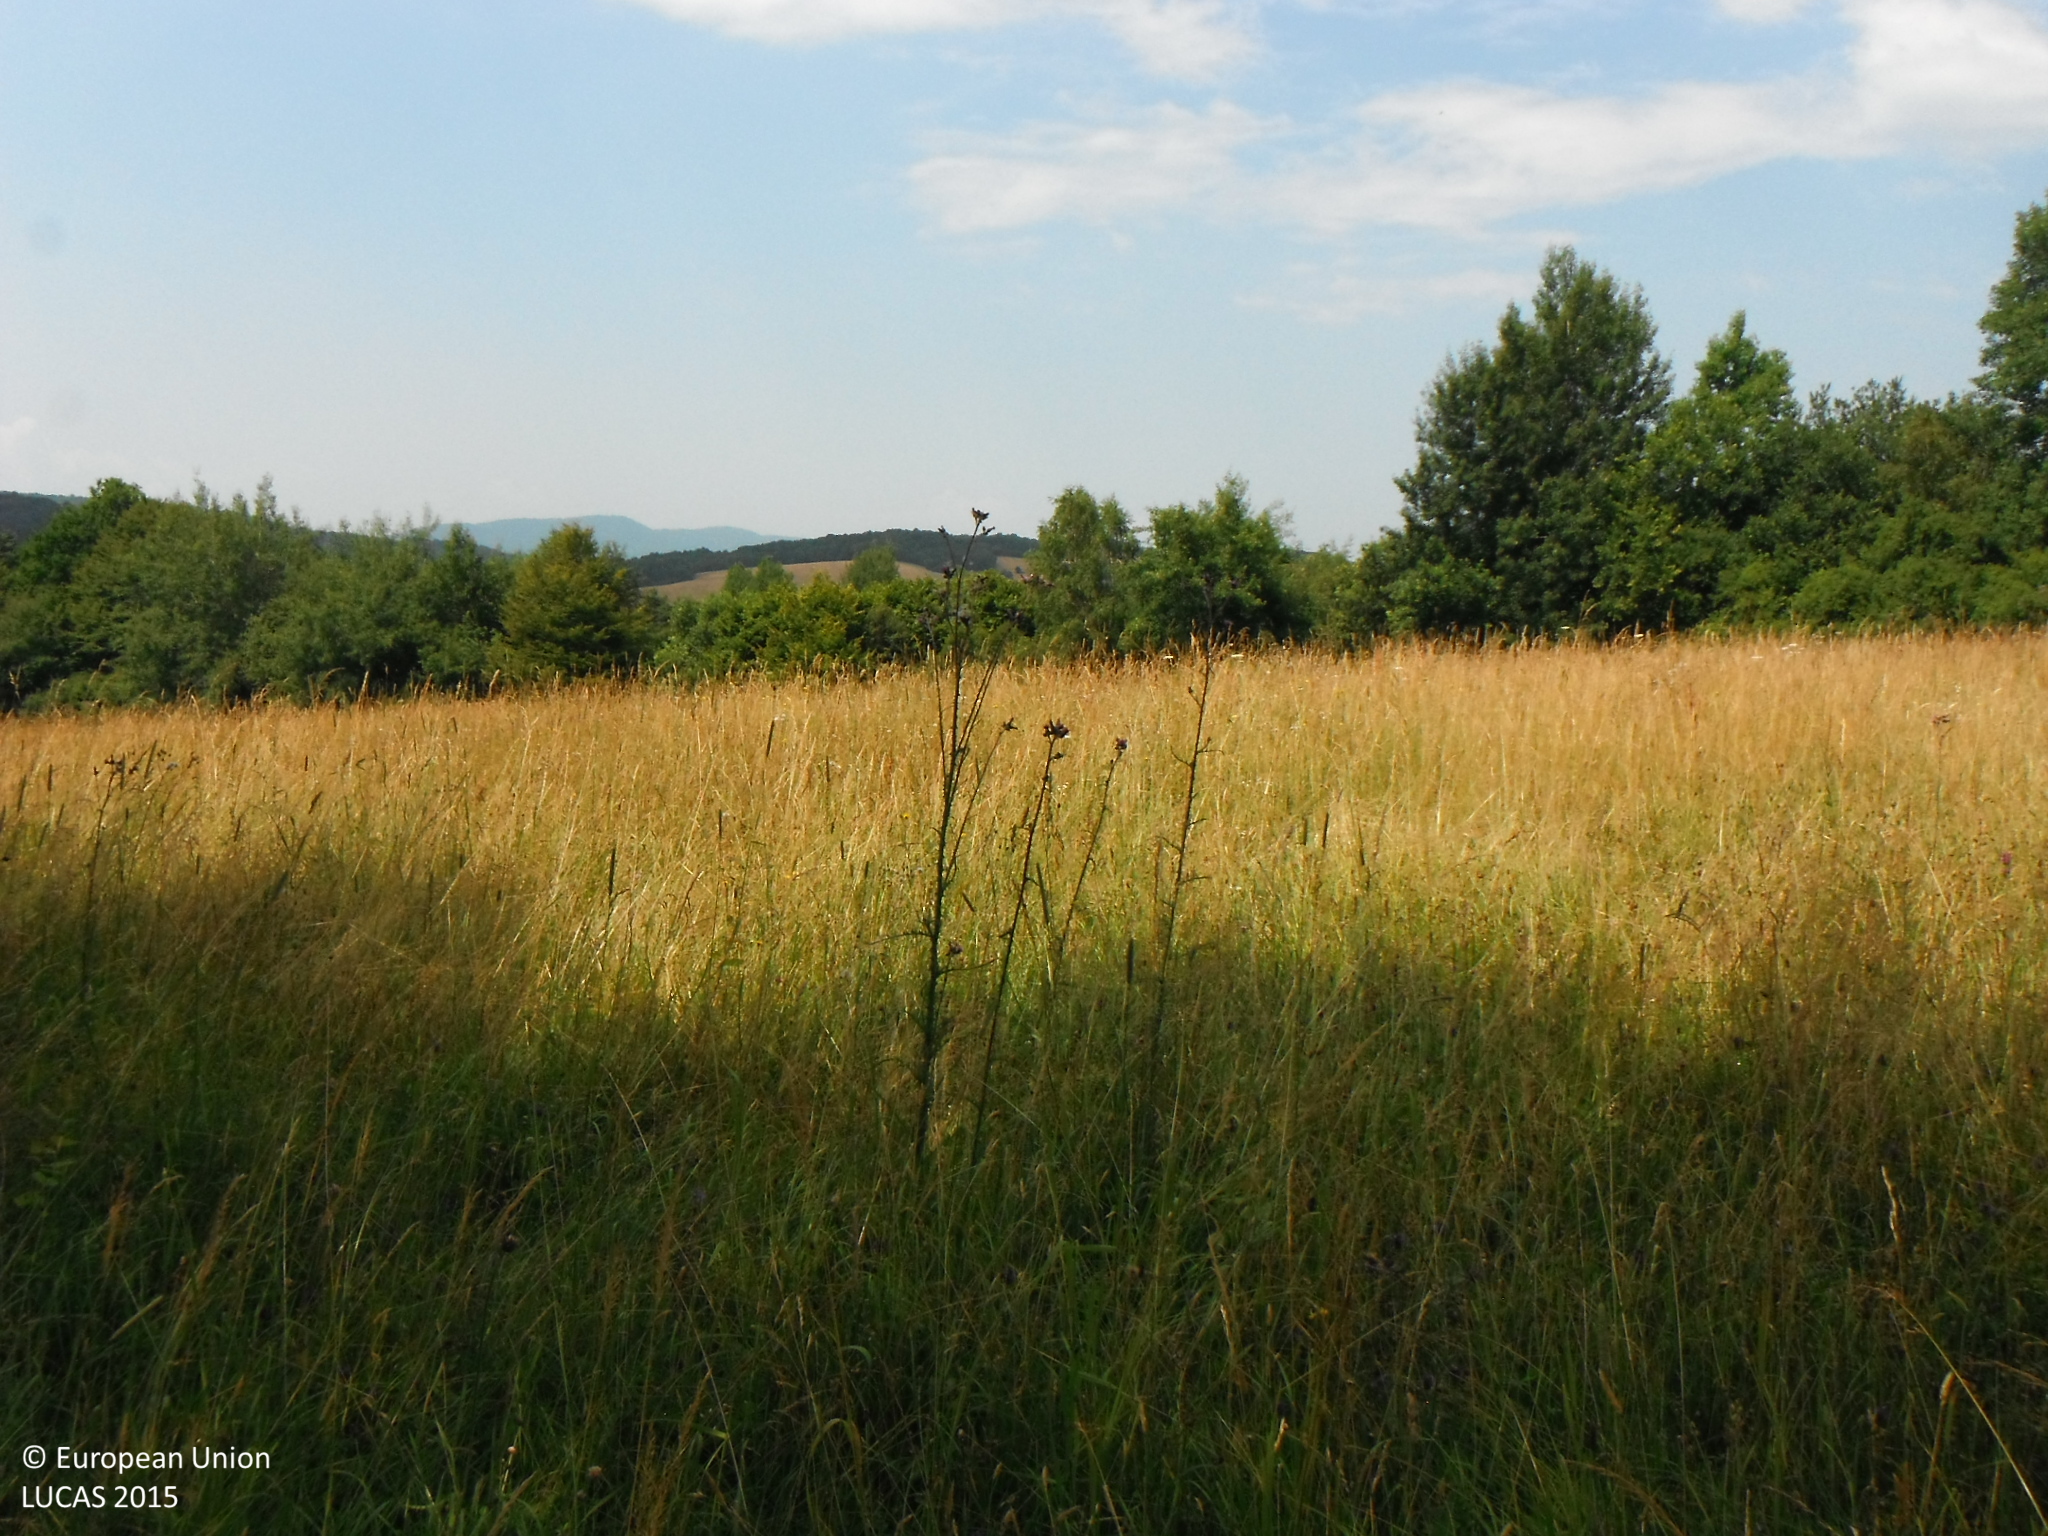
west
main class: Grassland
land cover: Grassland without tree/shrub cover
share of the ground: > 75 %
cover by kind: herbaceous plants 100 %
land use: Agriculture (excluding fallow land and kitchen gardens)
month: July
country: SK
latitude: 49.3732
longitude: 21.4101
